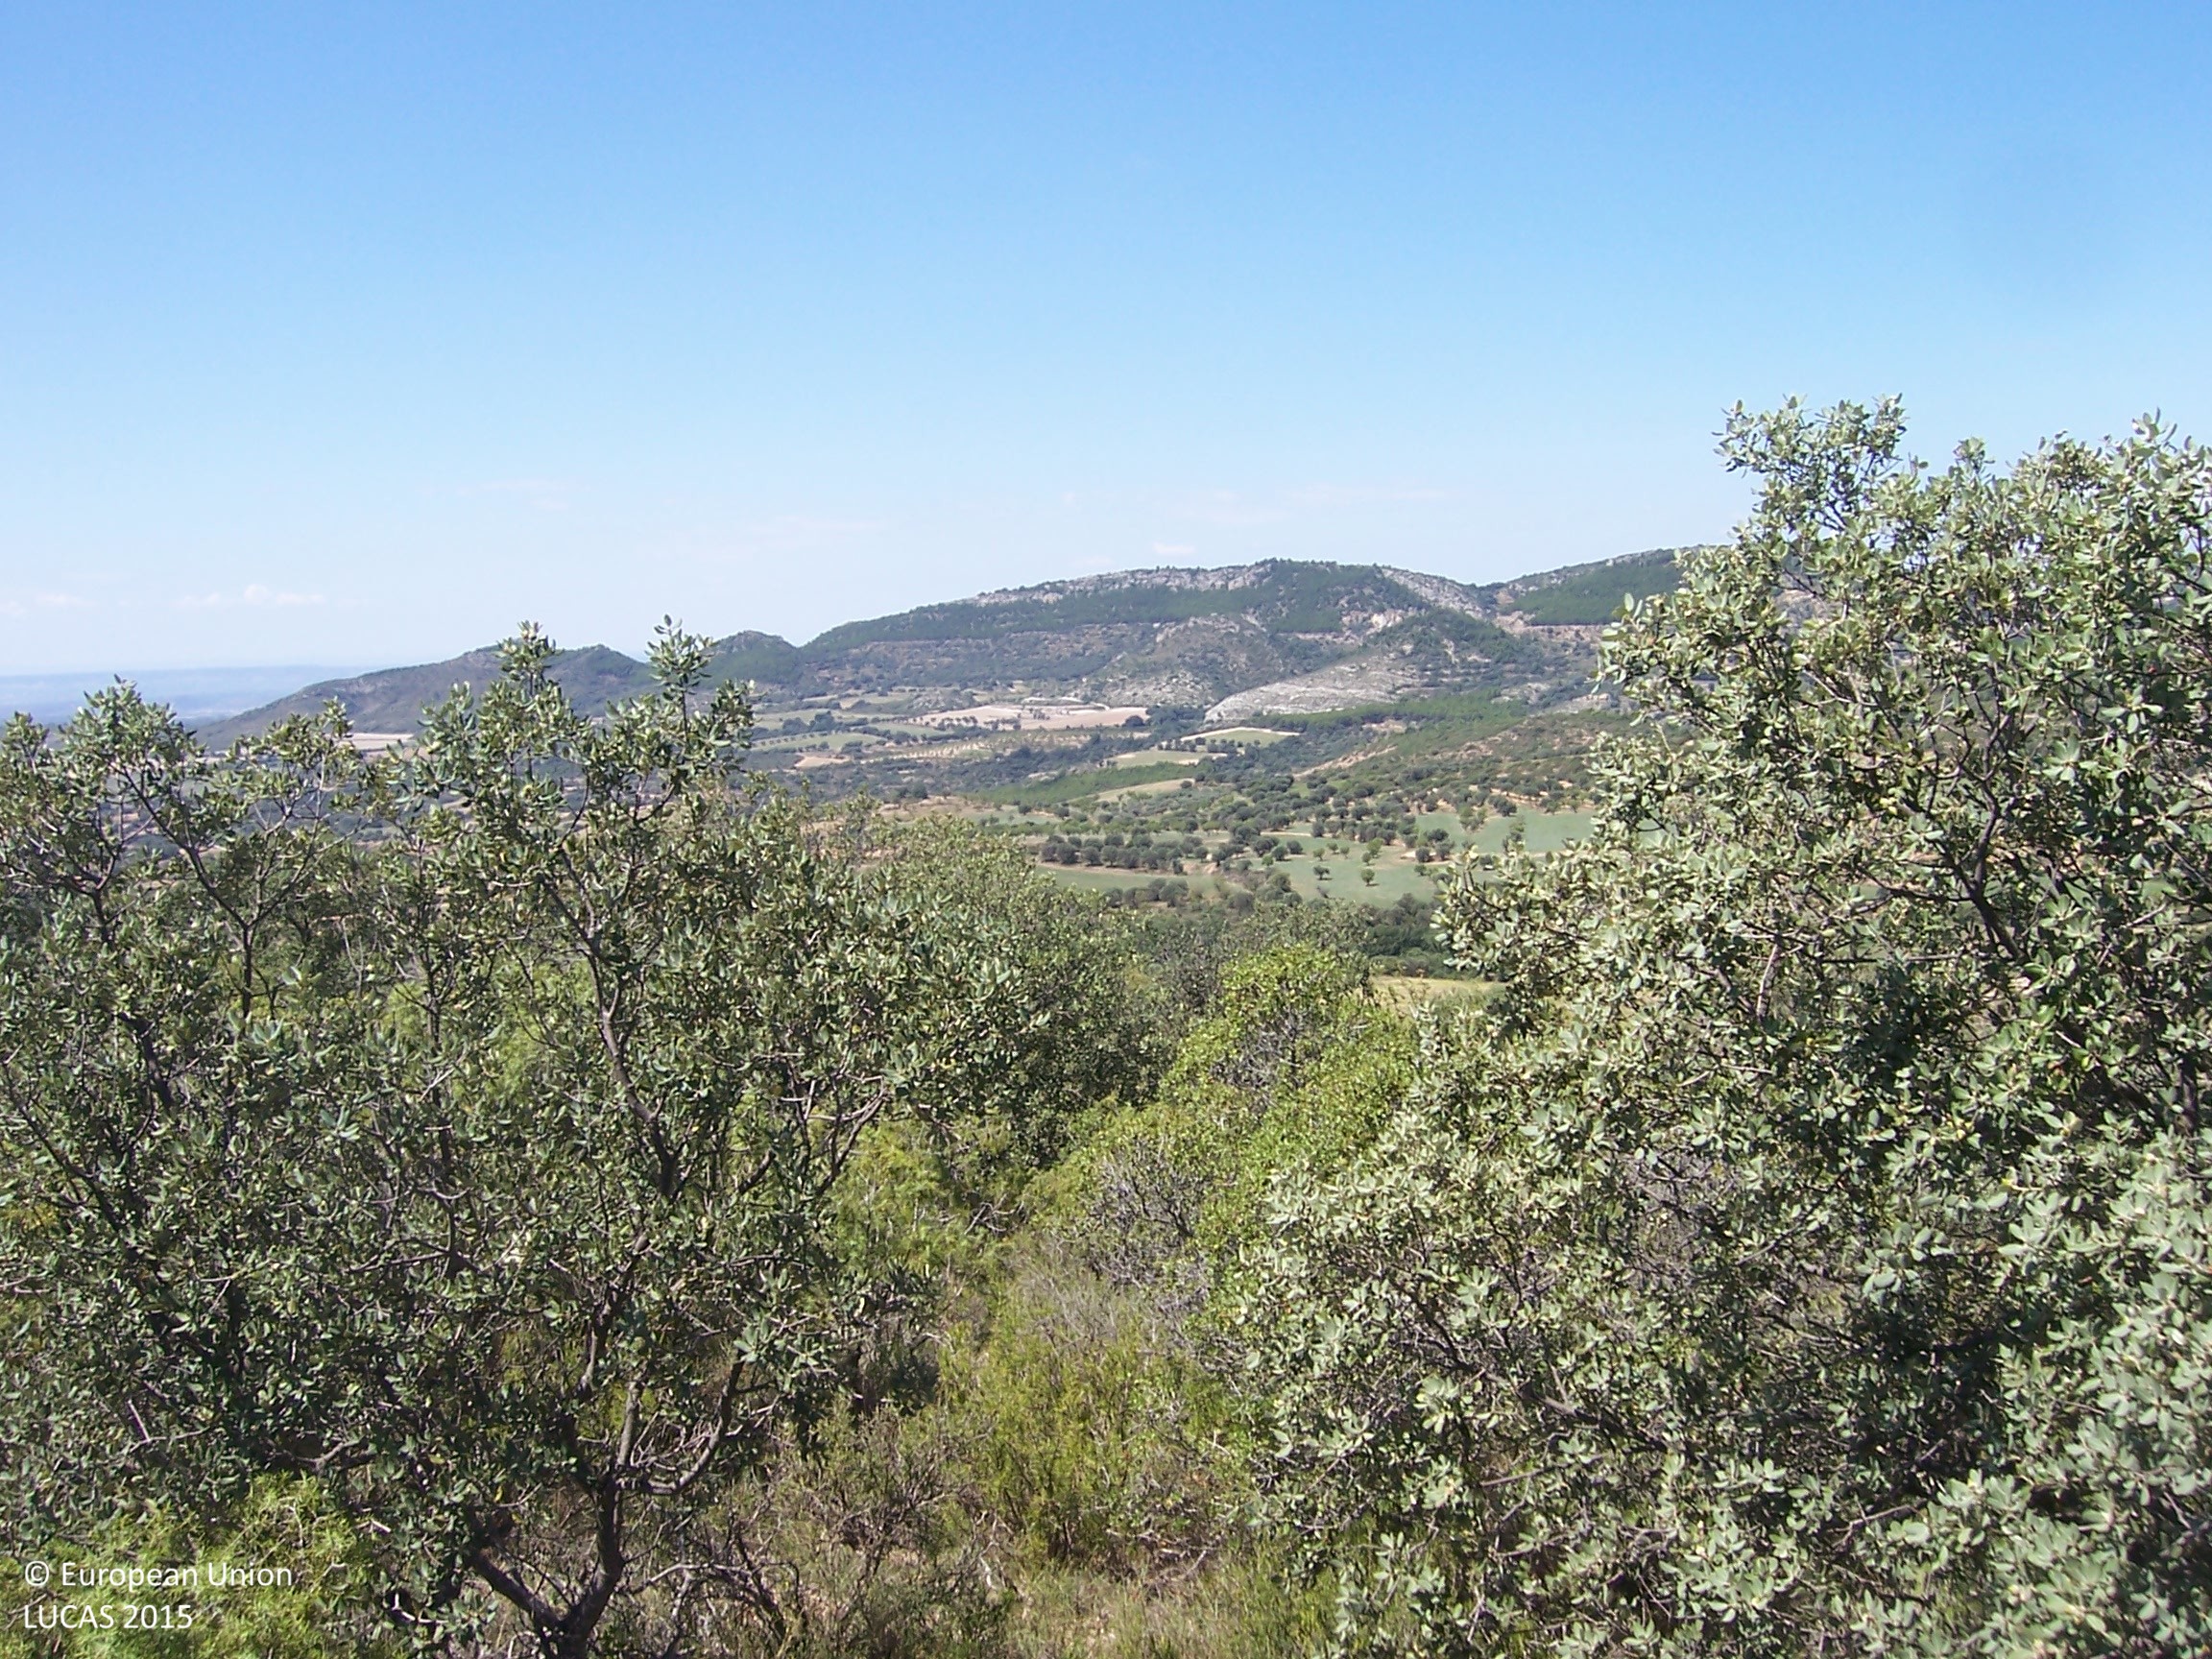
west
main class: Shrubland
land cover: Shrubland with sparse tree cover
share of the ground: > 75 %
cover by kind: shrubs 80 %, herbaceous plants 10 %, broadleaved forest trees 5 %, unconsolidated bare surface 5 %
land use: Semi-natural and natural areas not in use
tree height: < 5 m
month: August
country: ES
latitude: 42.0114
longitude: 0.3595
